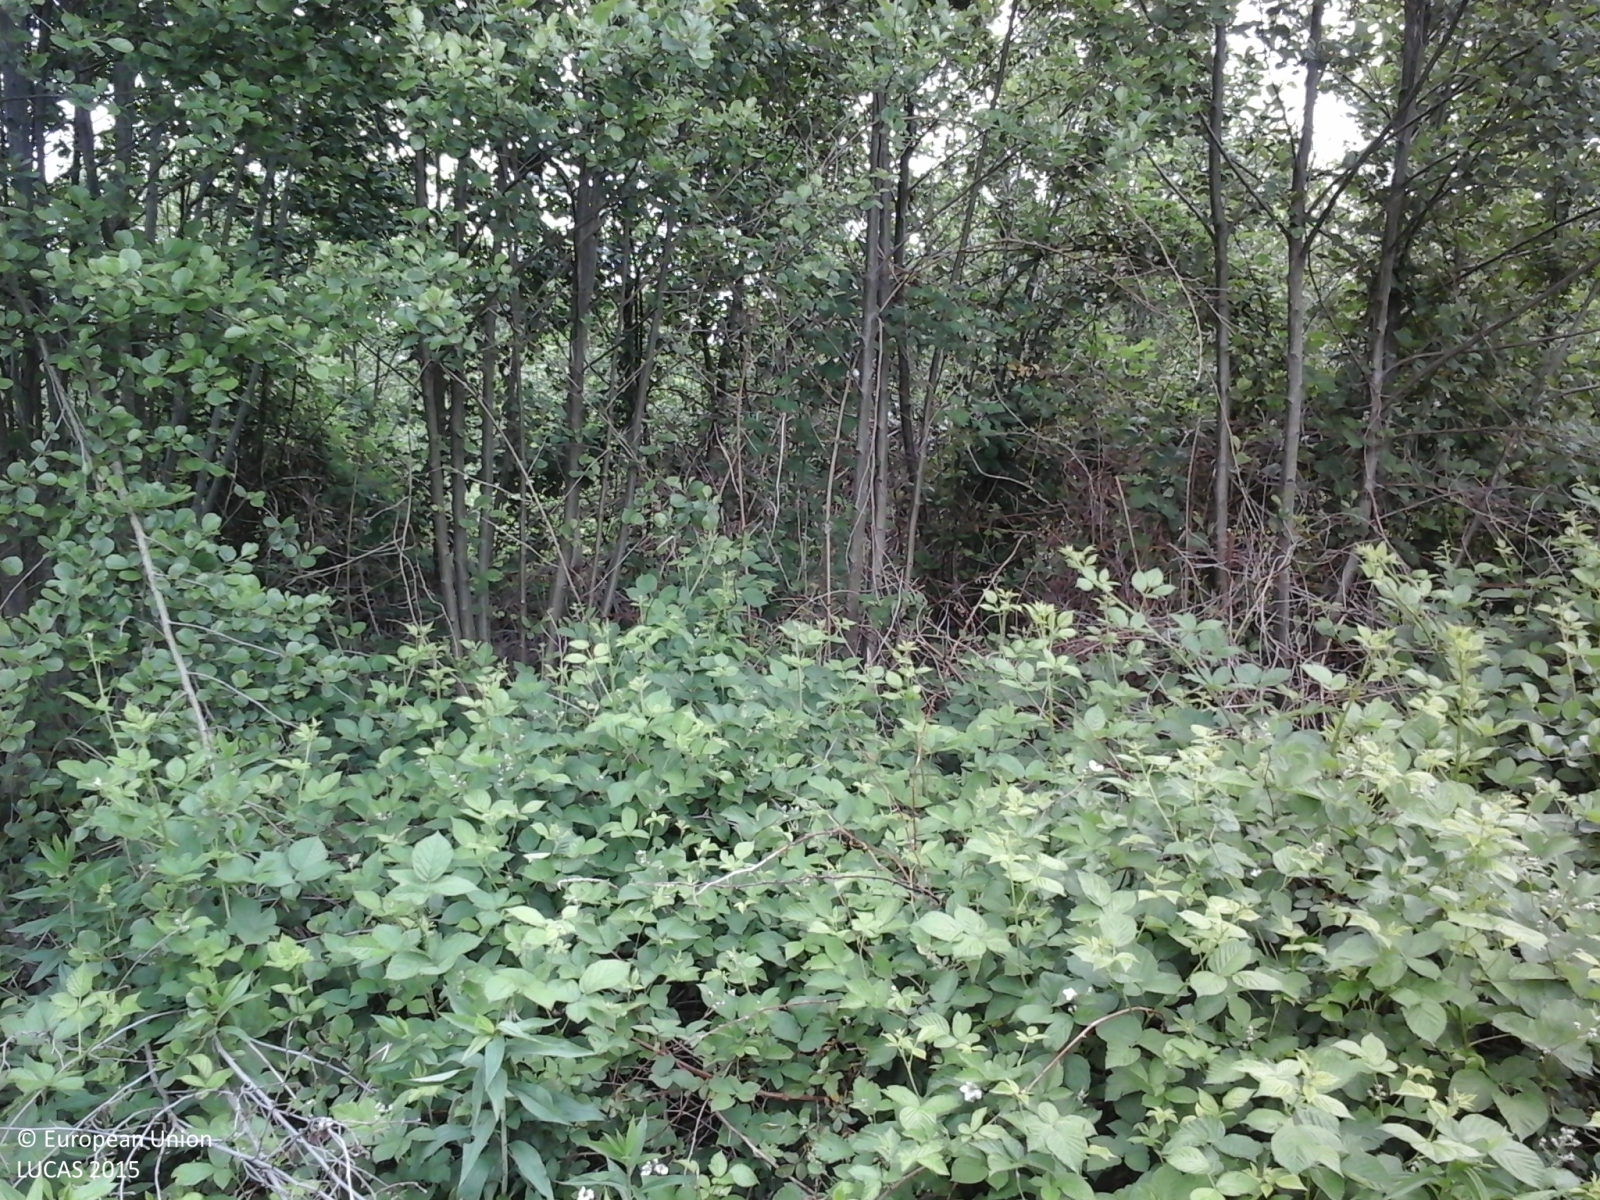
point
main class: Woodland
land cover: Broadleaved woodland
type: thermophilous deciduous forest
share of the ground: > 75 %
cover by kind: broadleaved forest trees 100 %
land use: Forestry
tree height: > 5 m
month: May
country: IT
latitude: 45.5460
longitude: 8.3760
